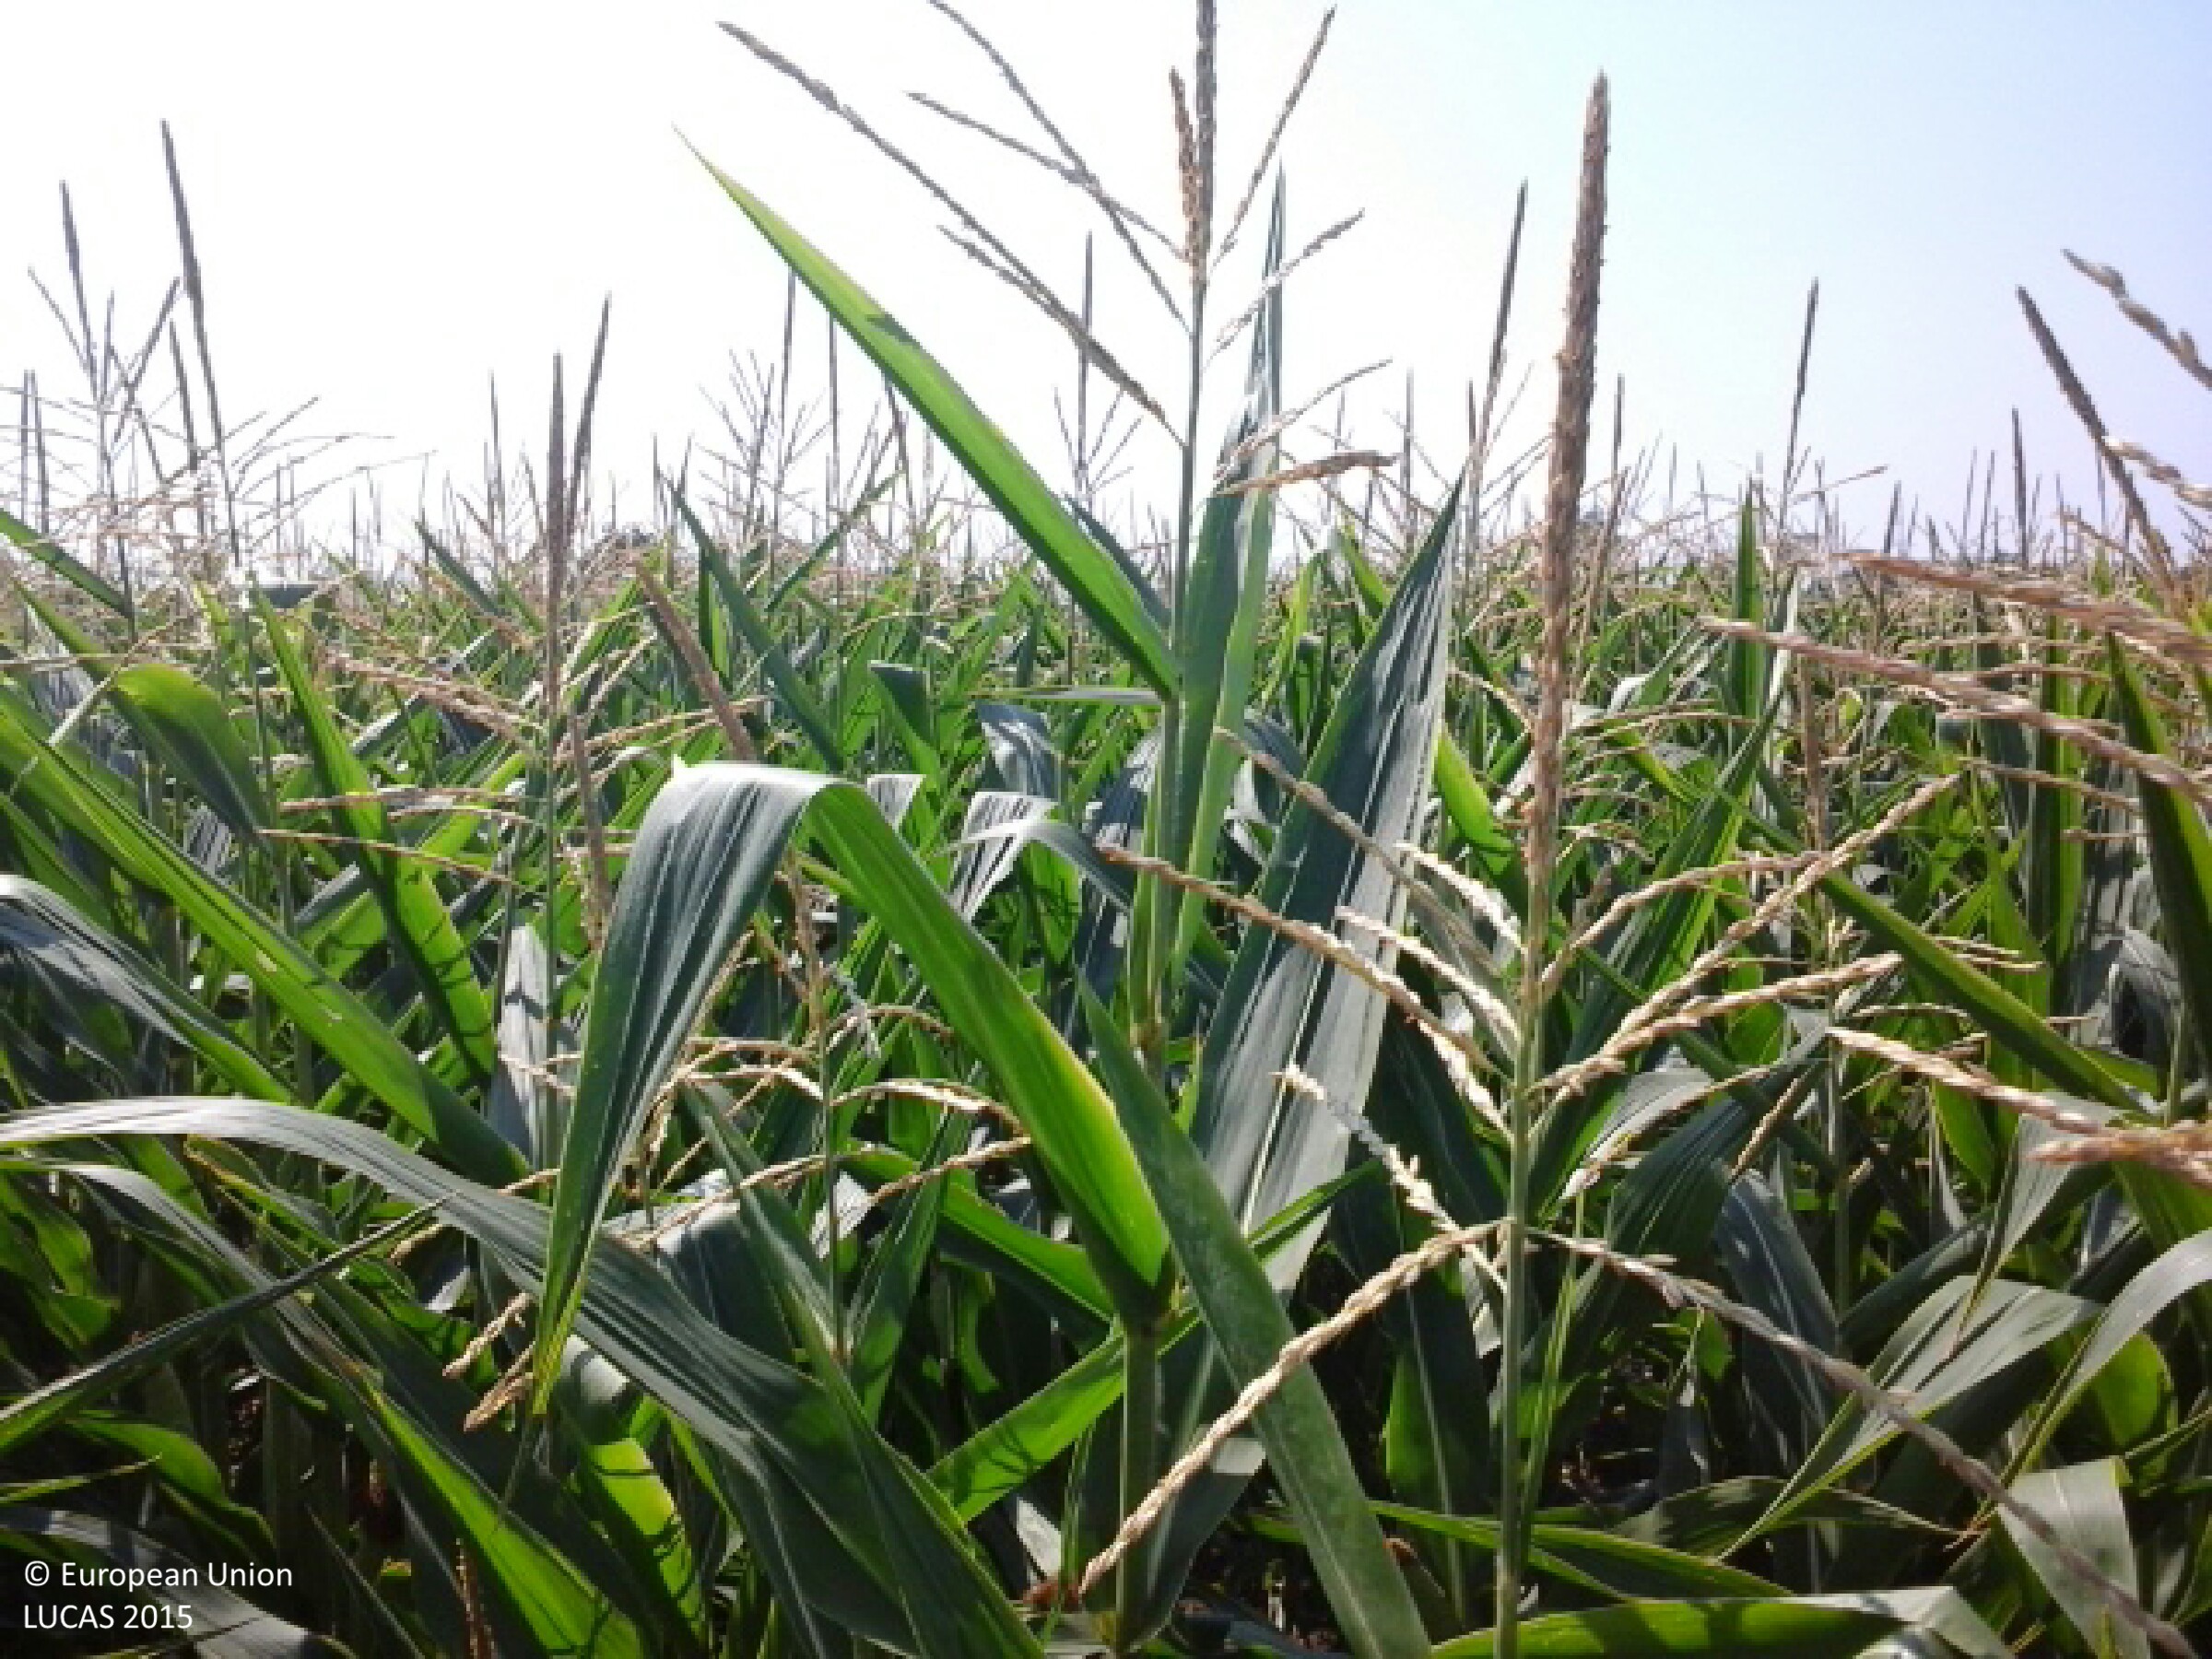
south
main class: Cropland
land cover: Maize
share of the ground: > 75 %
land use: Agriculture (excluding fallow land and kitchen gardens)
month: August
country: HU
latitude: 47.5829
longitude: 18.0822
